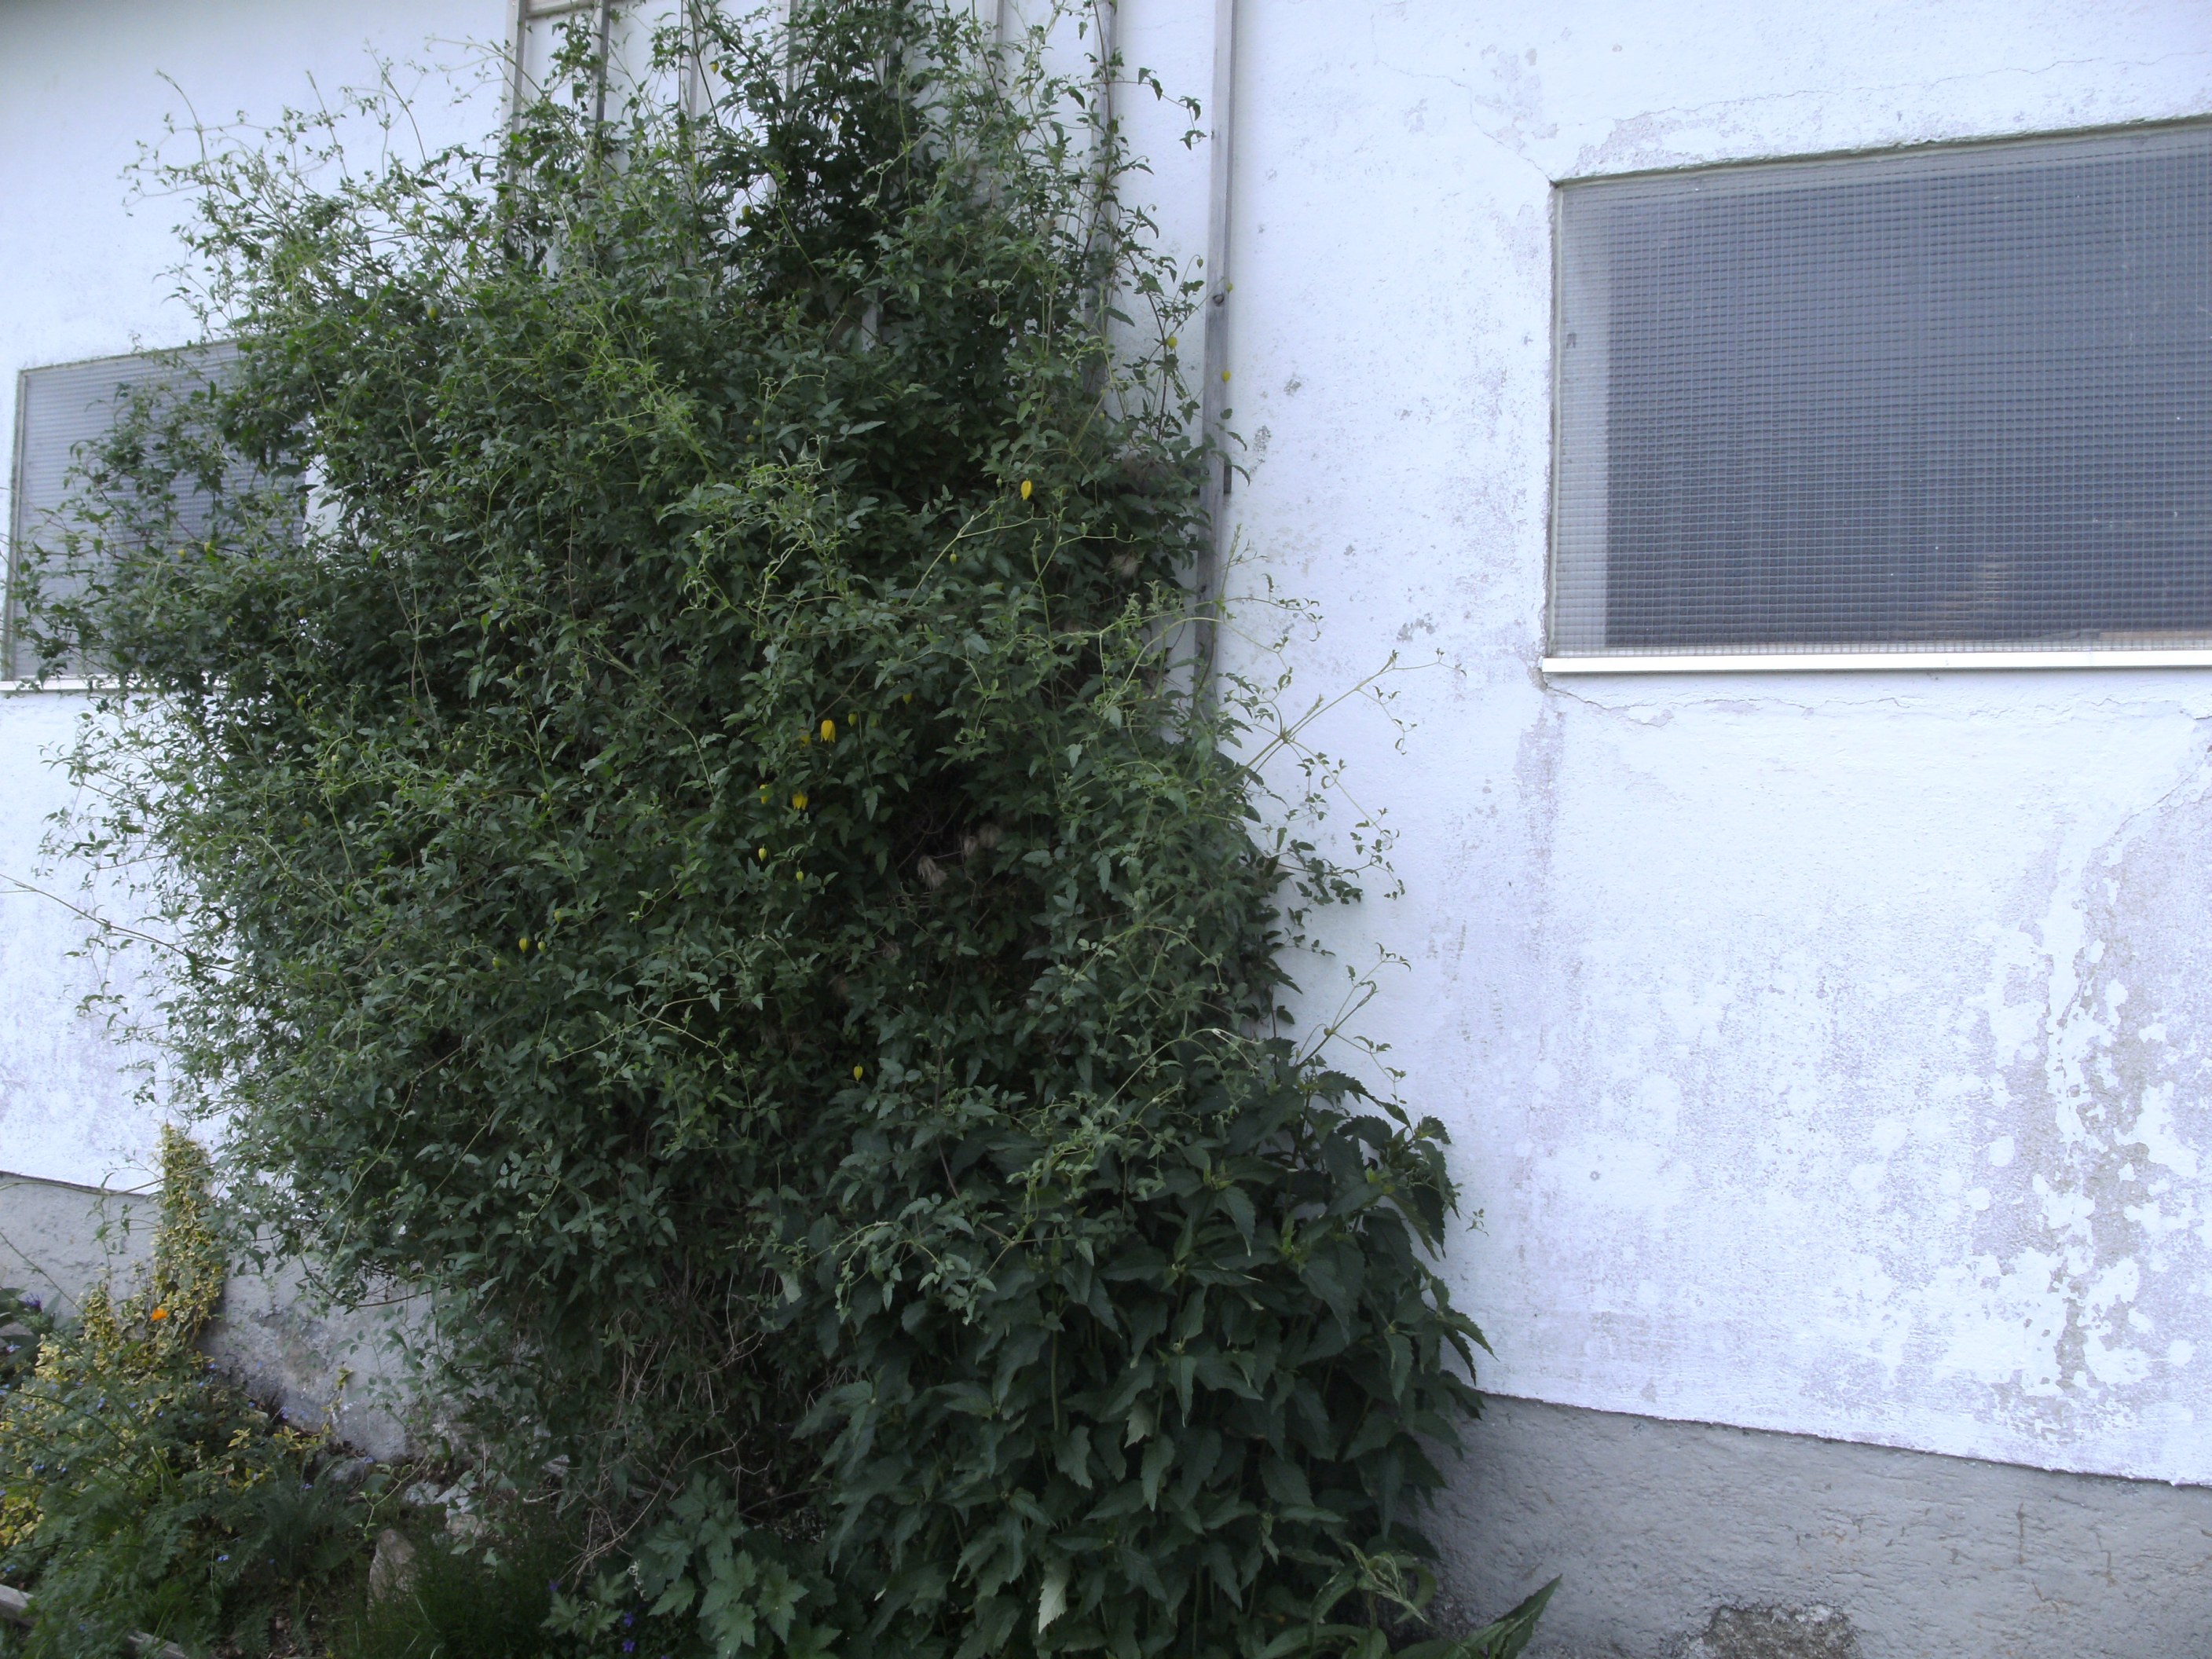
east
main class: Grassland
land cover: Grassland without tree/shrub cover
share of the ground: > 75 %
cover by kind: herbaceous plants 100 %
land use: Agriculture (excluding fallow land and kitchen gardens)
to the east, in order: Grassland without tree/shrub cover; Artificial constructions in urban areas; Grassland without tree/shrub cover; Electric lines; Grassland without tree/shrub cover
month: June
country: AT
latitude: 48.5585
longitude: 14.1870
